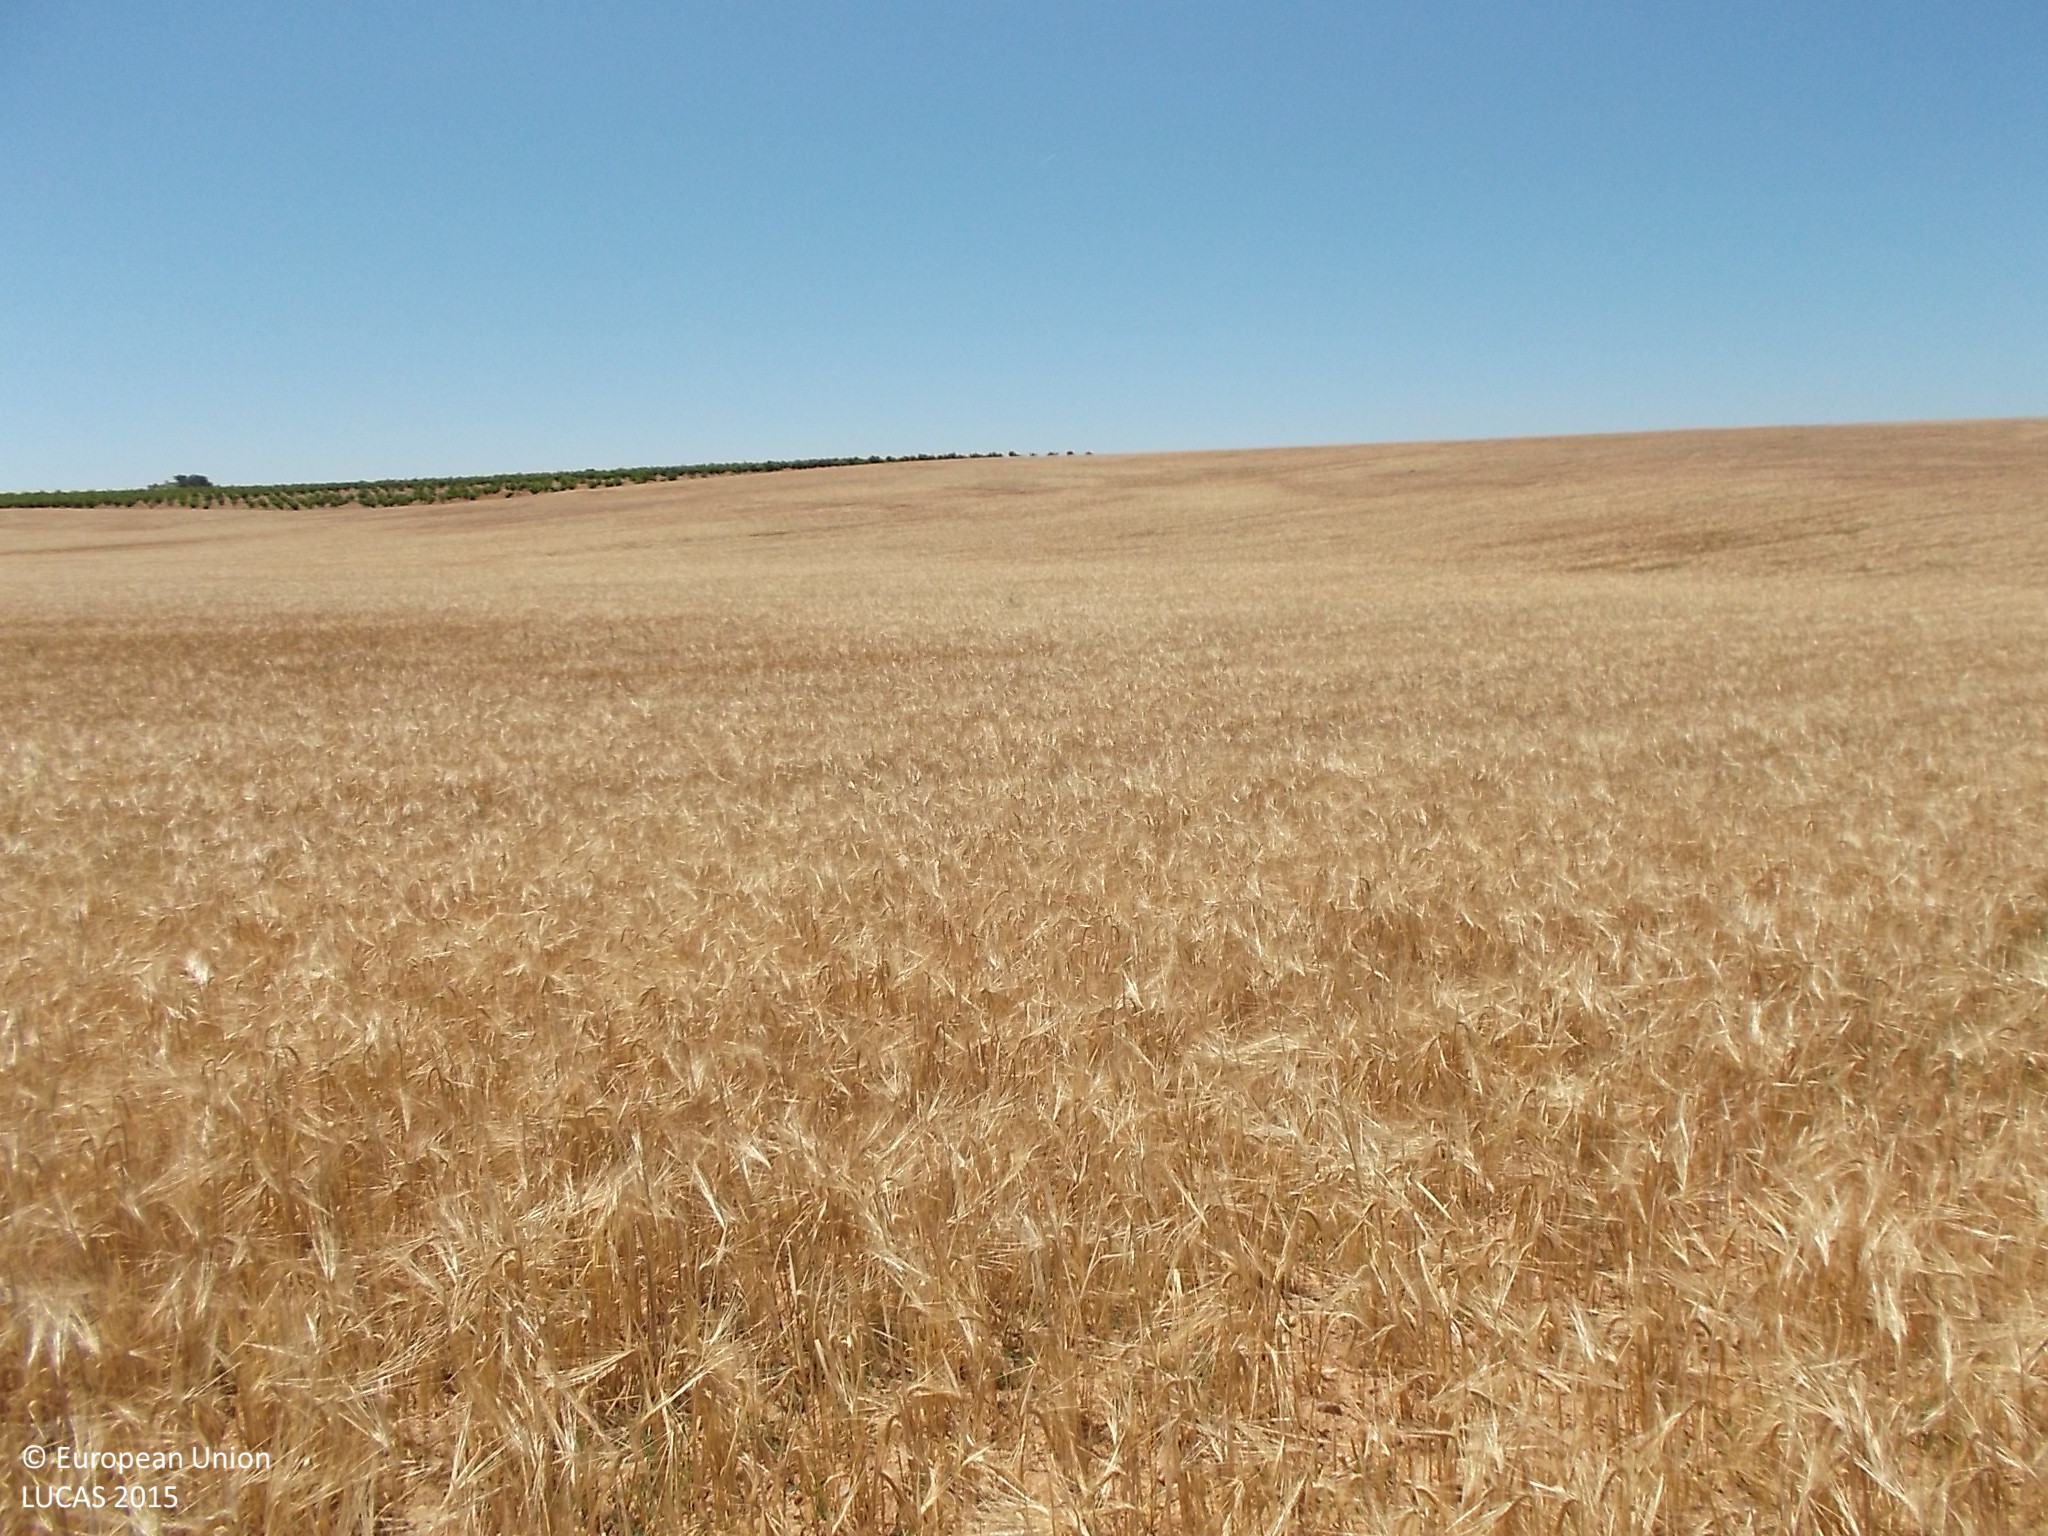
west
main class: Cropland
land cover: Barley
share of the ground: > 75 %
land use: Agriculture (excluding fallow land and kitchen gardens)
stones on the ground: < 10 %
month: June
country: ES
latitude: 41.4021
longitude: -5.3521
